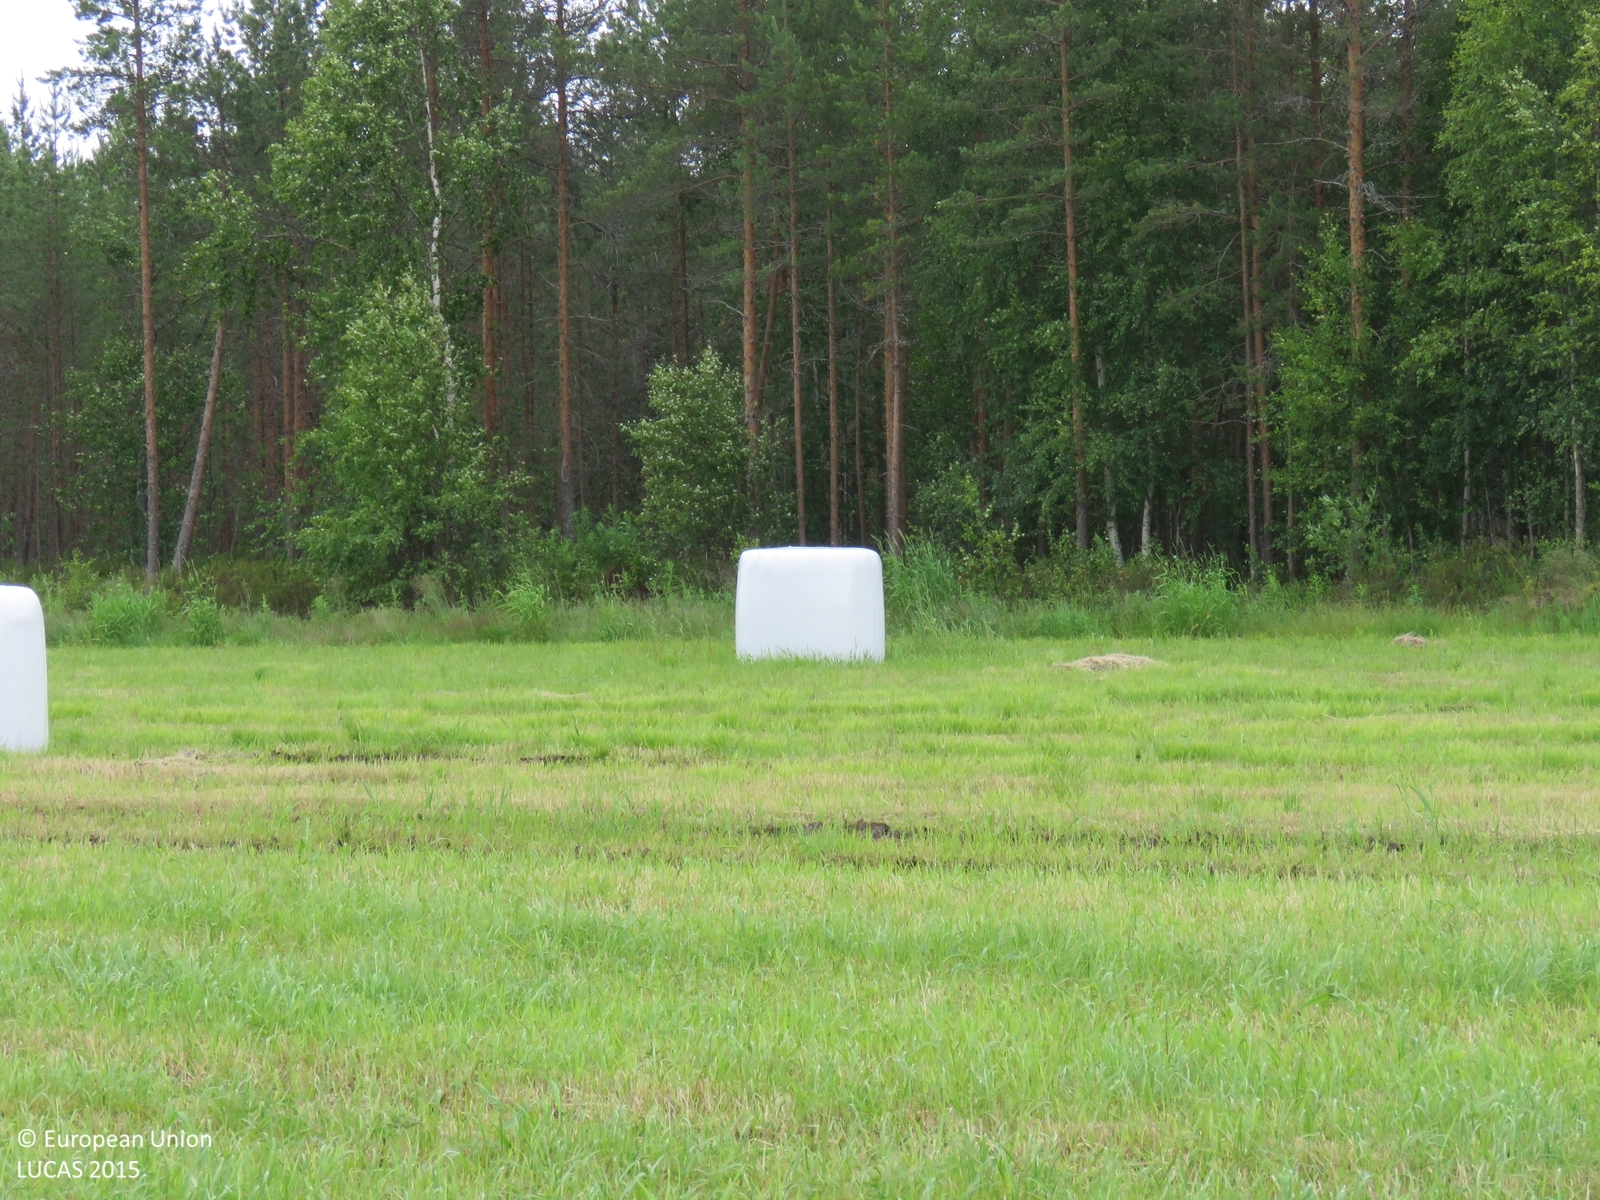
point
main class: Cropland
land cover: Temporary grasslands
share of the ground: > 75 %
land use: Agriculture (excluding fallow land and kitchen gardens)
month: July
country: FI
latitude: 64.4156
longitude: 26.3202
